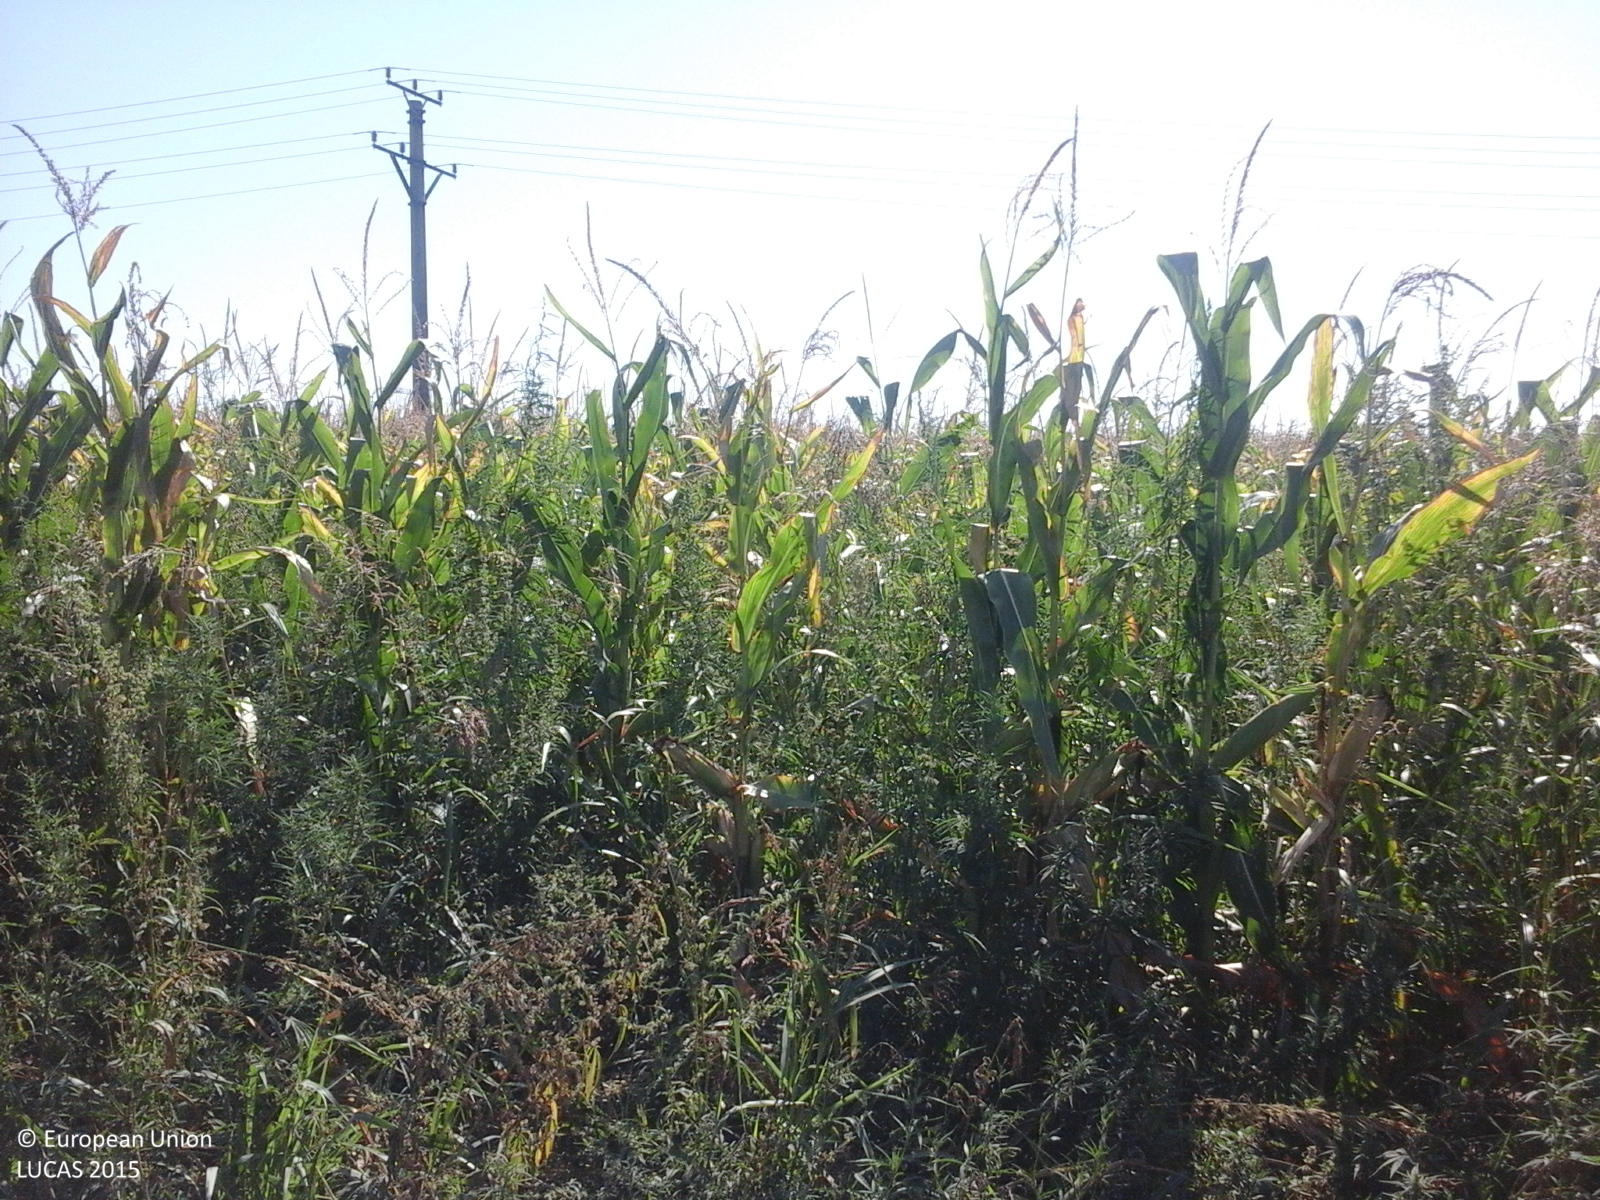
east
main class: Cropland
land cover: Maize
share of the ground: > 75 %
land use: Agriculture (excluding fallow land and kitchen gardens)
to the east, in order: Maize; Spontaneously vegetated surfaces; Grass margins; Tracks; Grass margins; Maize; Electric lines; Maize
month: August
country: RO
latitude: 44.6595
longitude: 28.2133
